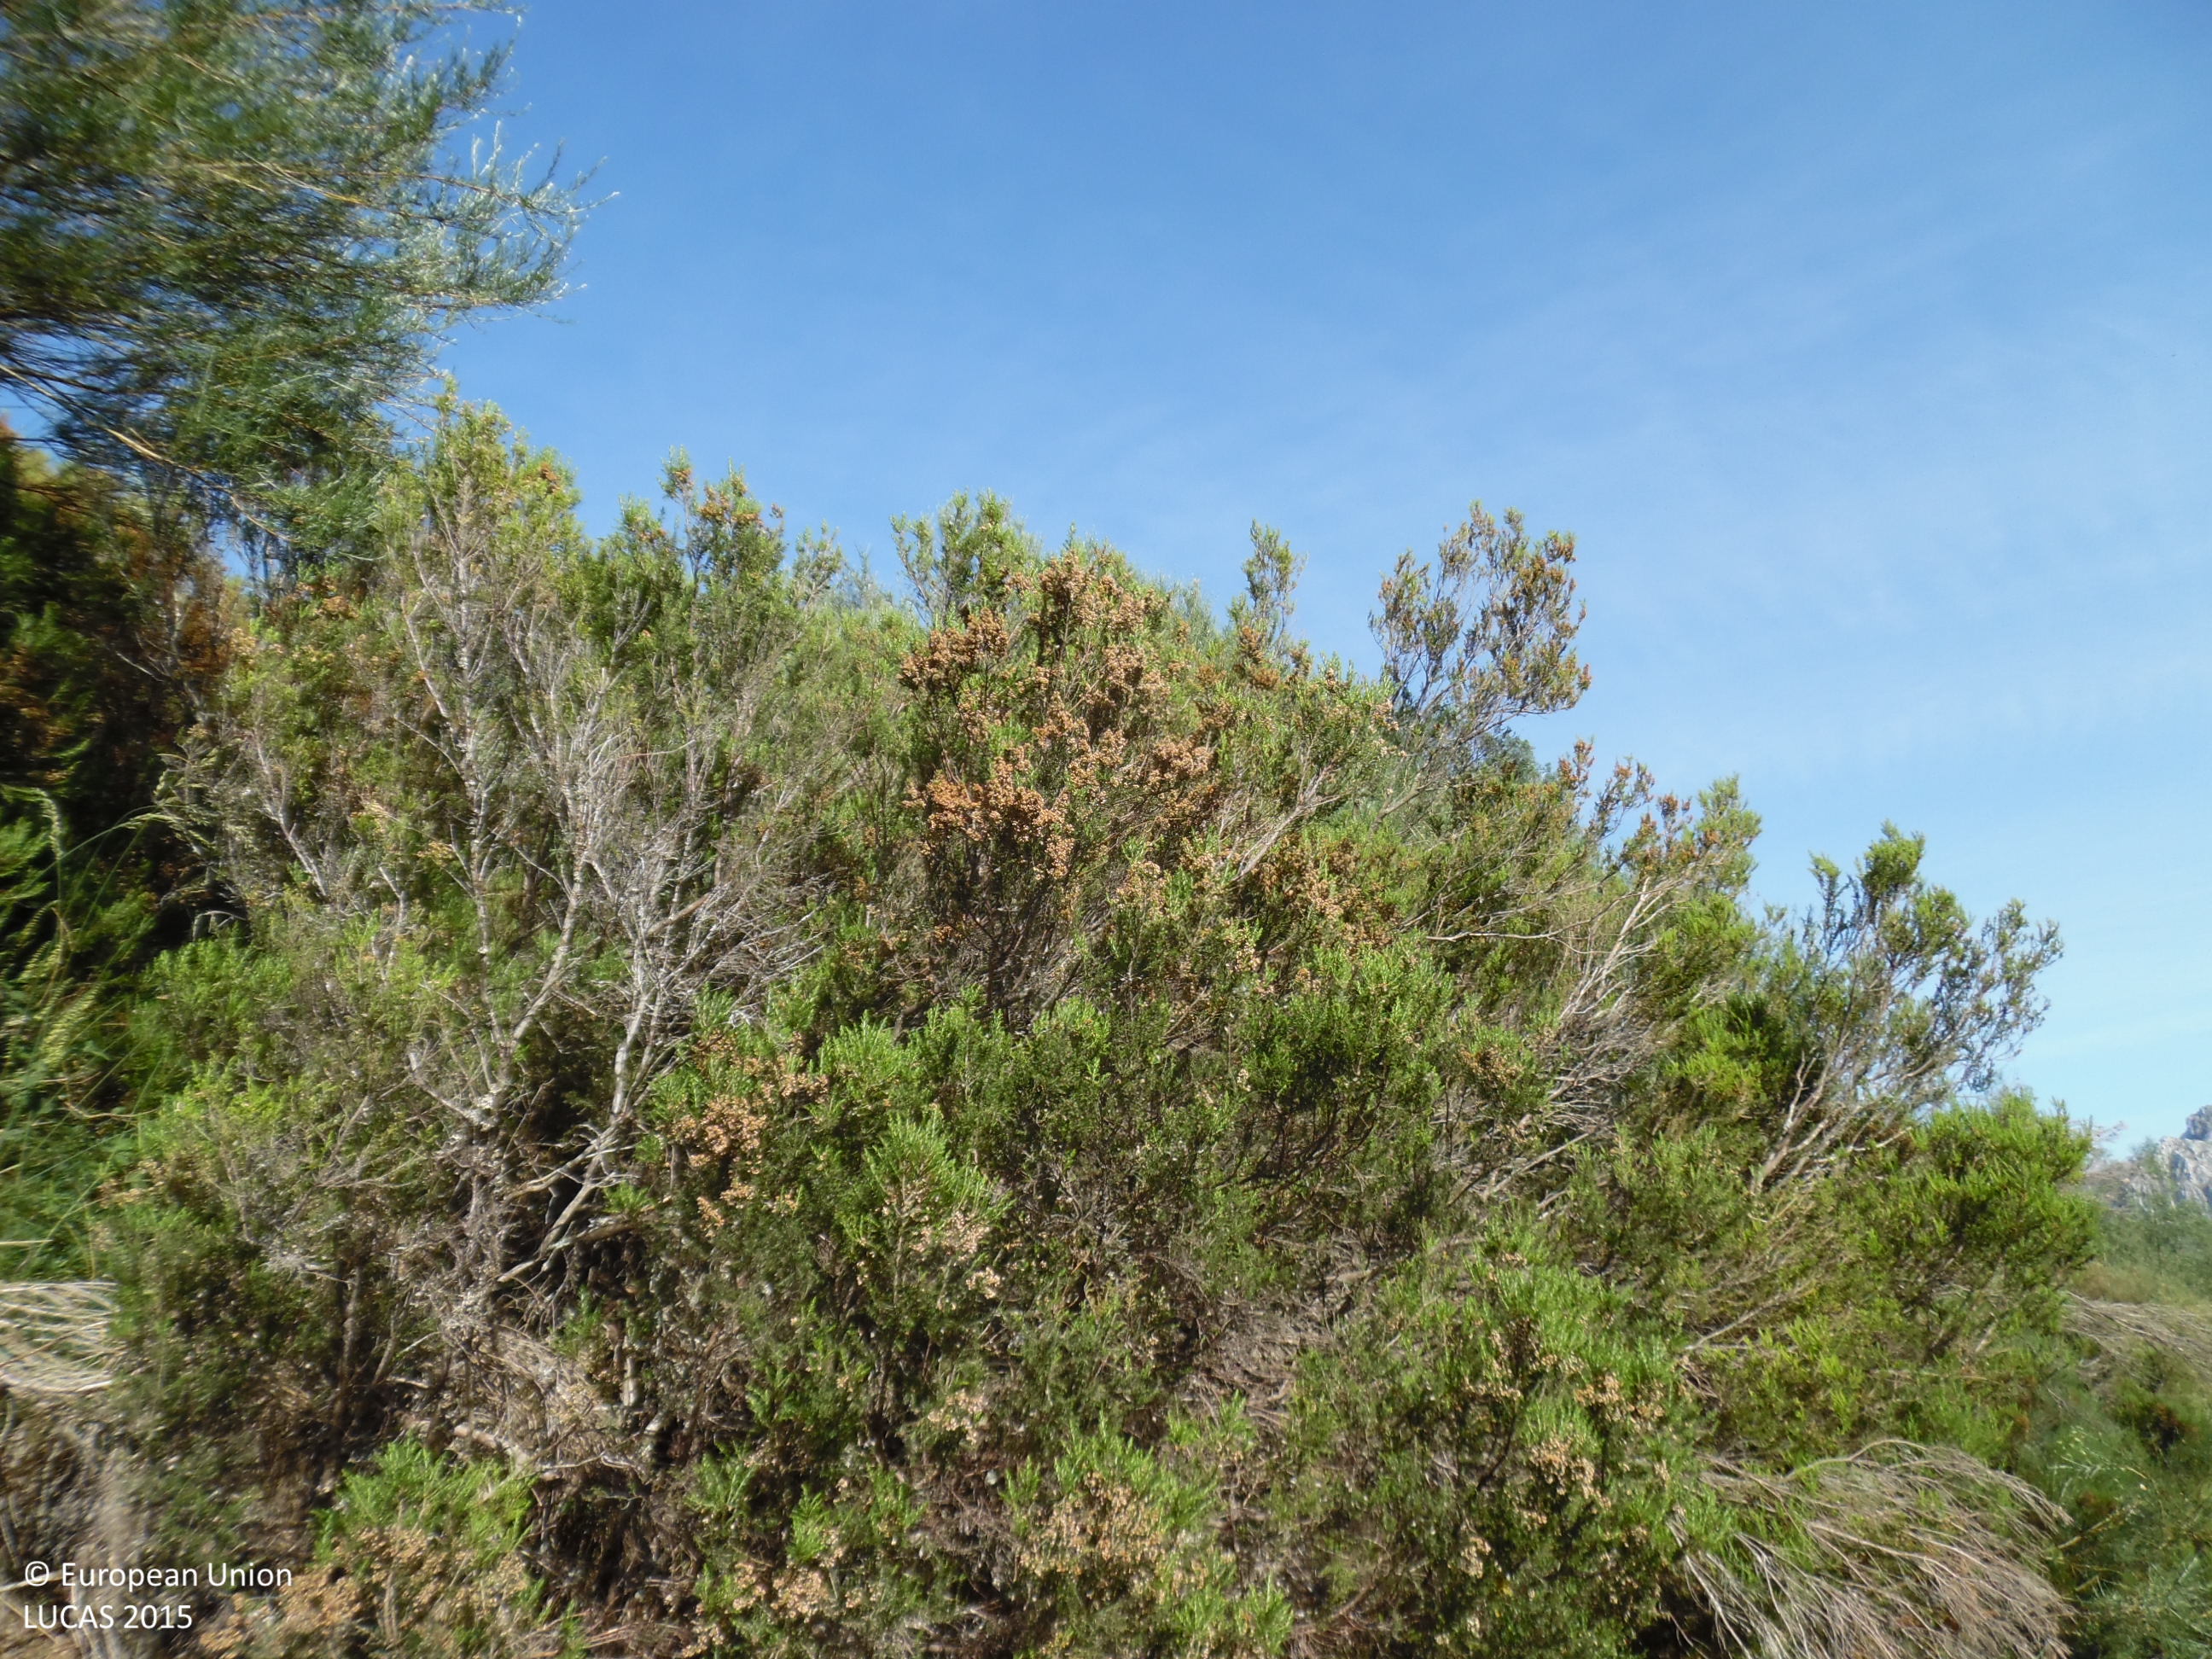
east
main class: Shrubland
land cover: Shrubland without tree cover
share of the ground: > 75 %
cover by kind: shrubs 100 %
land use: Abandoned areas
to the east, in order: Shrubland without tree cover; Shrubland with sparse tree cover; Other structural elements
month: July
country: ES
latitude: 42.9810
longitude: -5.4650
